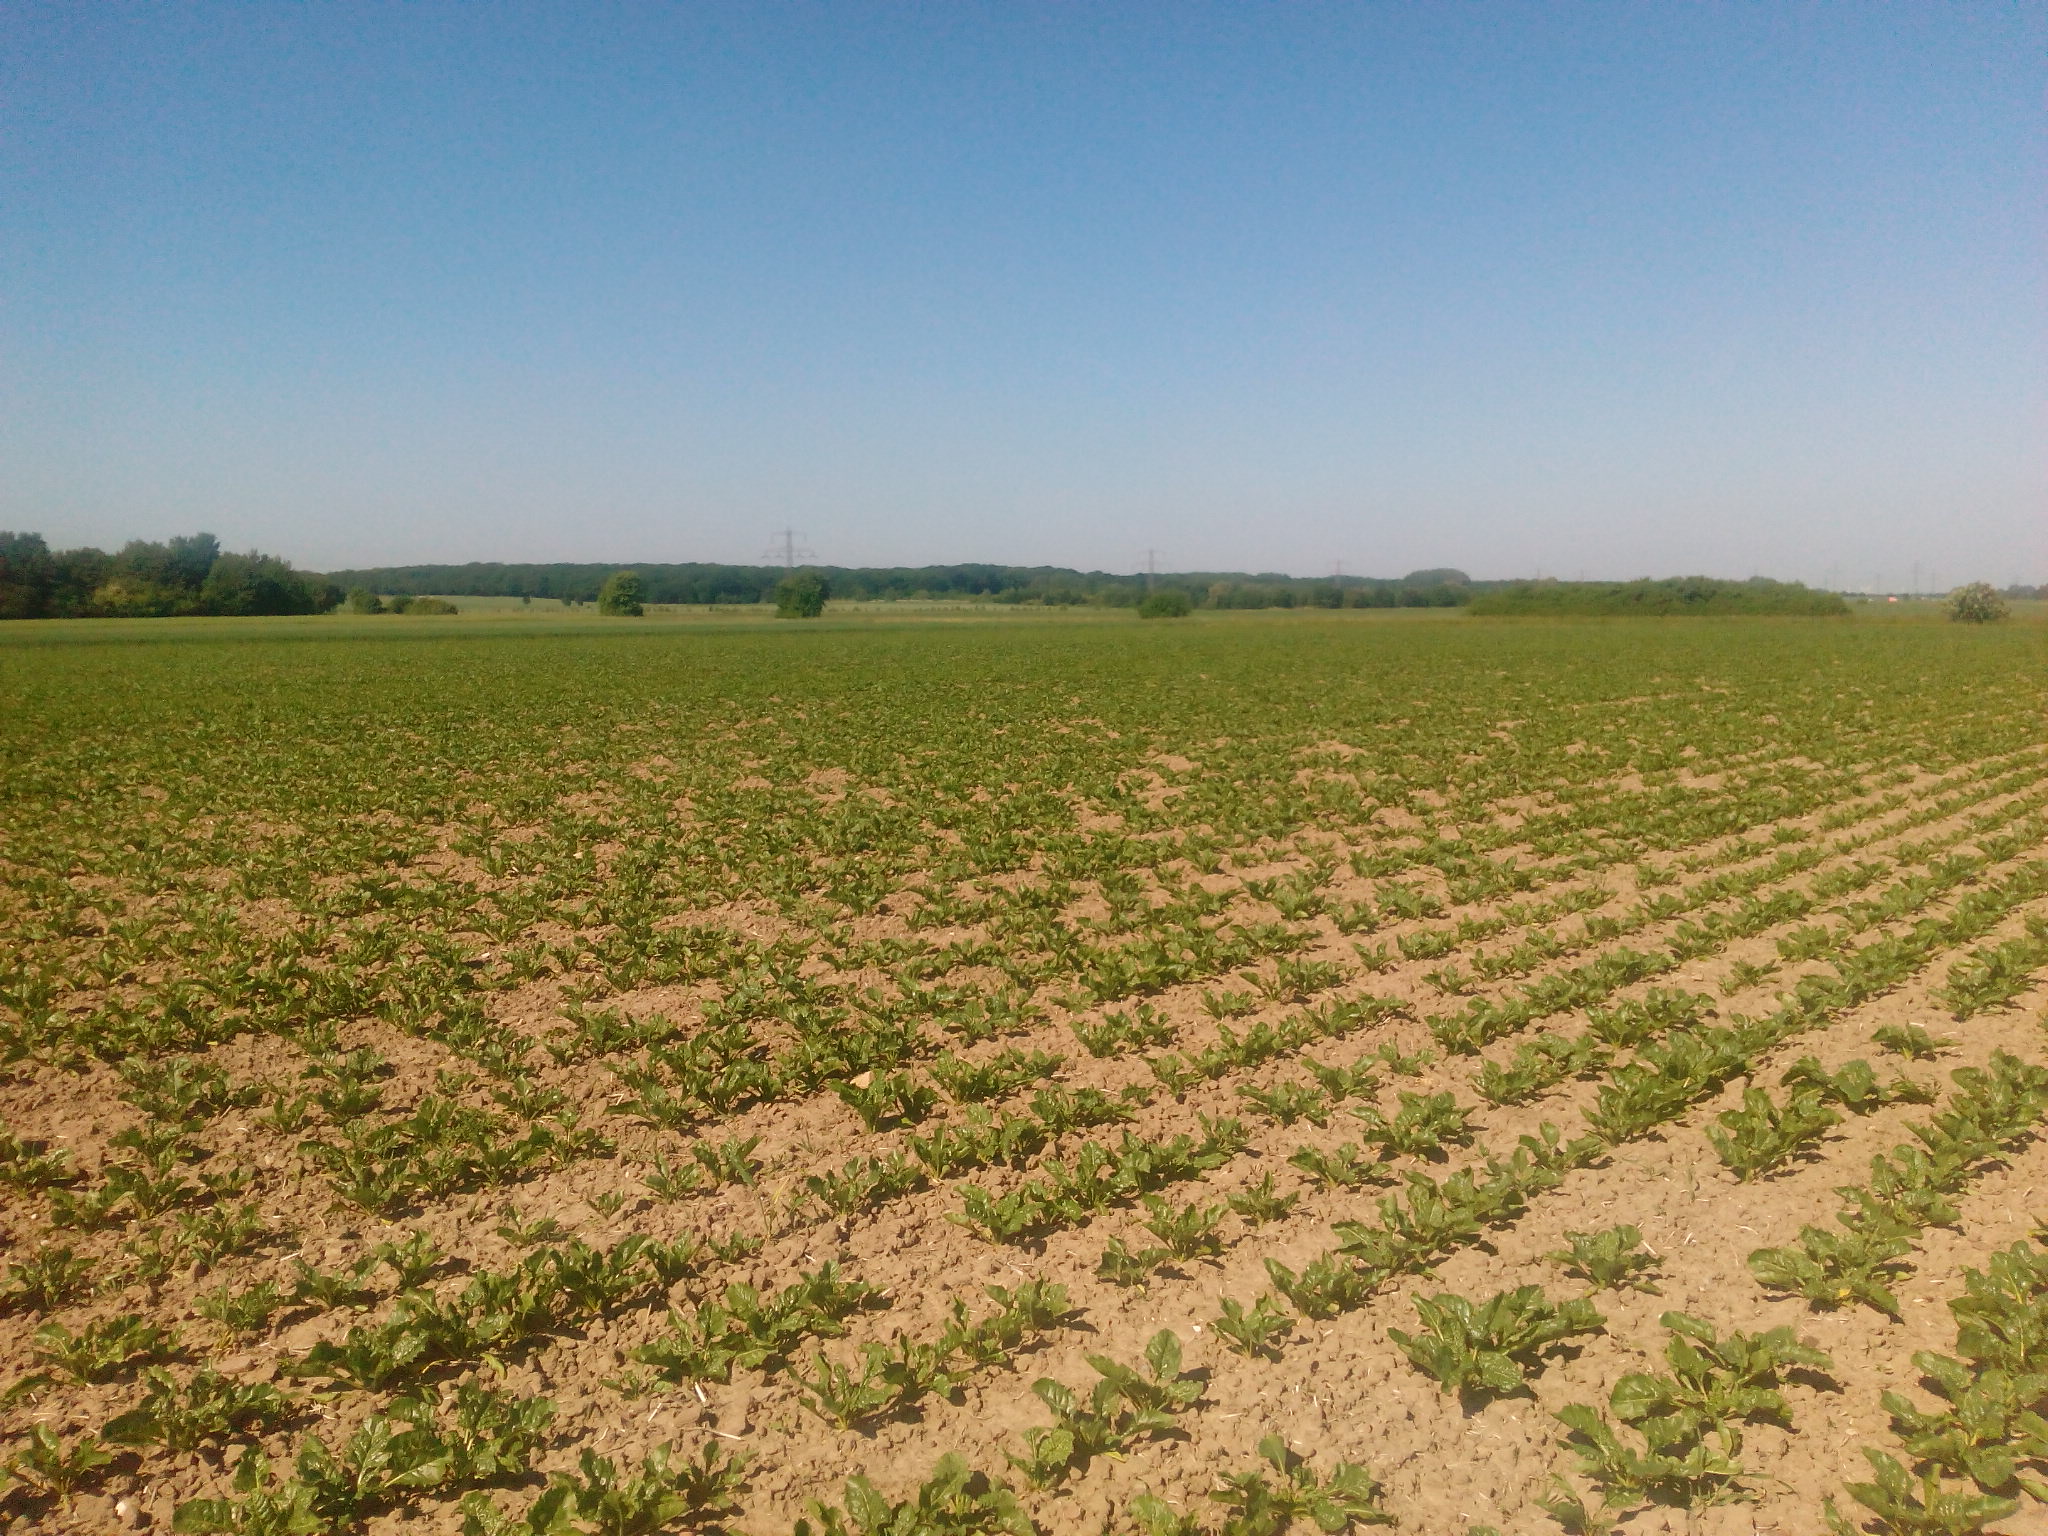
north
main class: Cropland
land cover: Sugar beet
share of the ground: 25 - 50 %
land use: Agriculture (excluding fallow land and kitchen gardens)
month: June
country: DE
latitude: 52.2875
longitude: 9.8681
